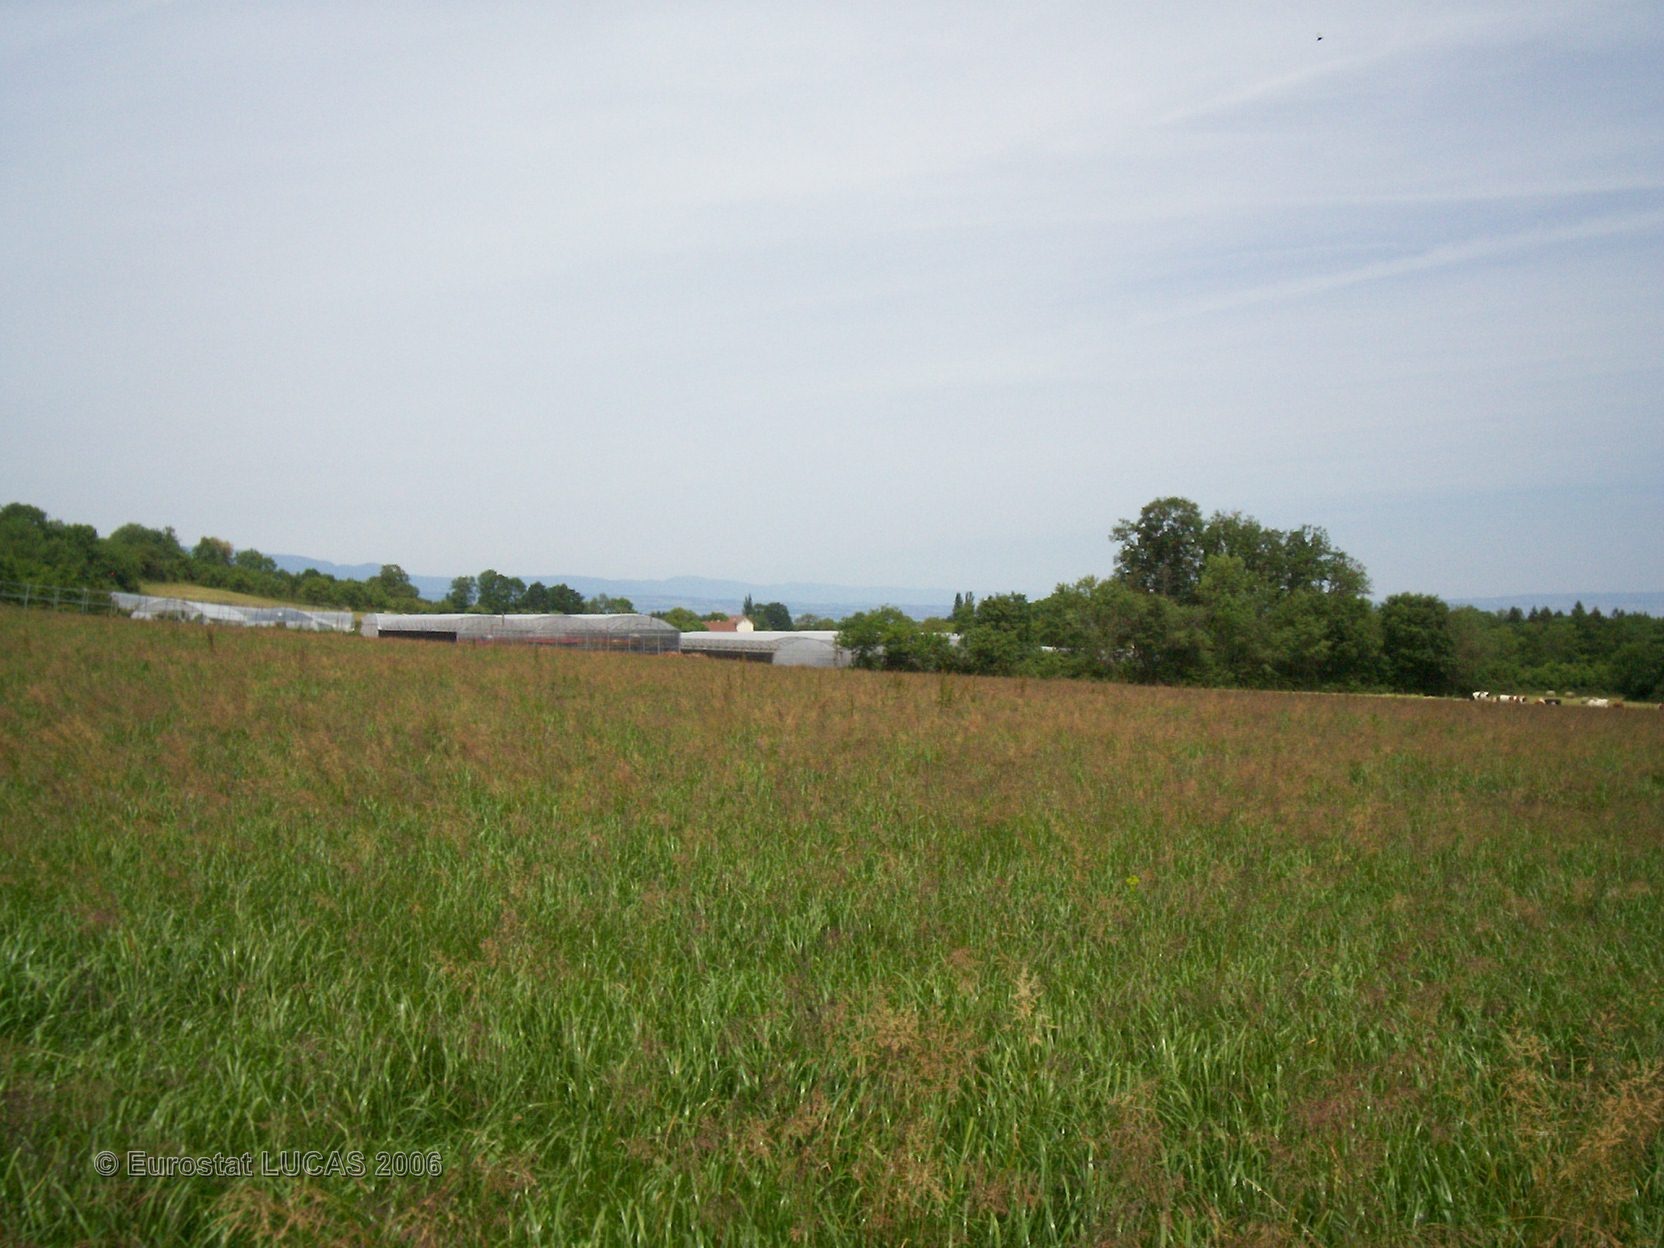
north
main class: Grassland
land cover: Grassland without tree/shrub cover
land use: Agriculture (excluding fallow land and kitchen gardens)
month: June
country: FR
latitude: 46.3080
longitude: 6.3806
